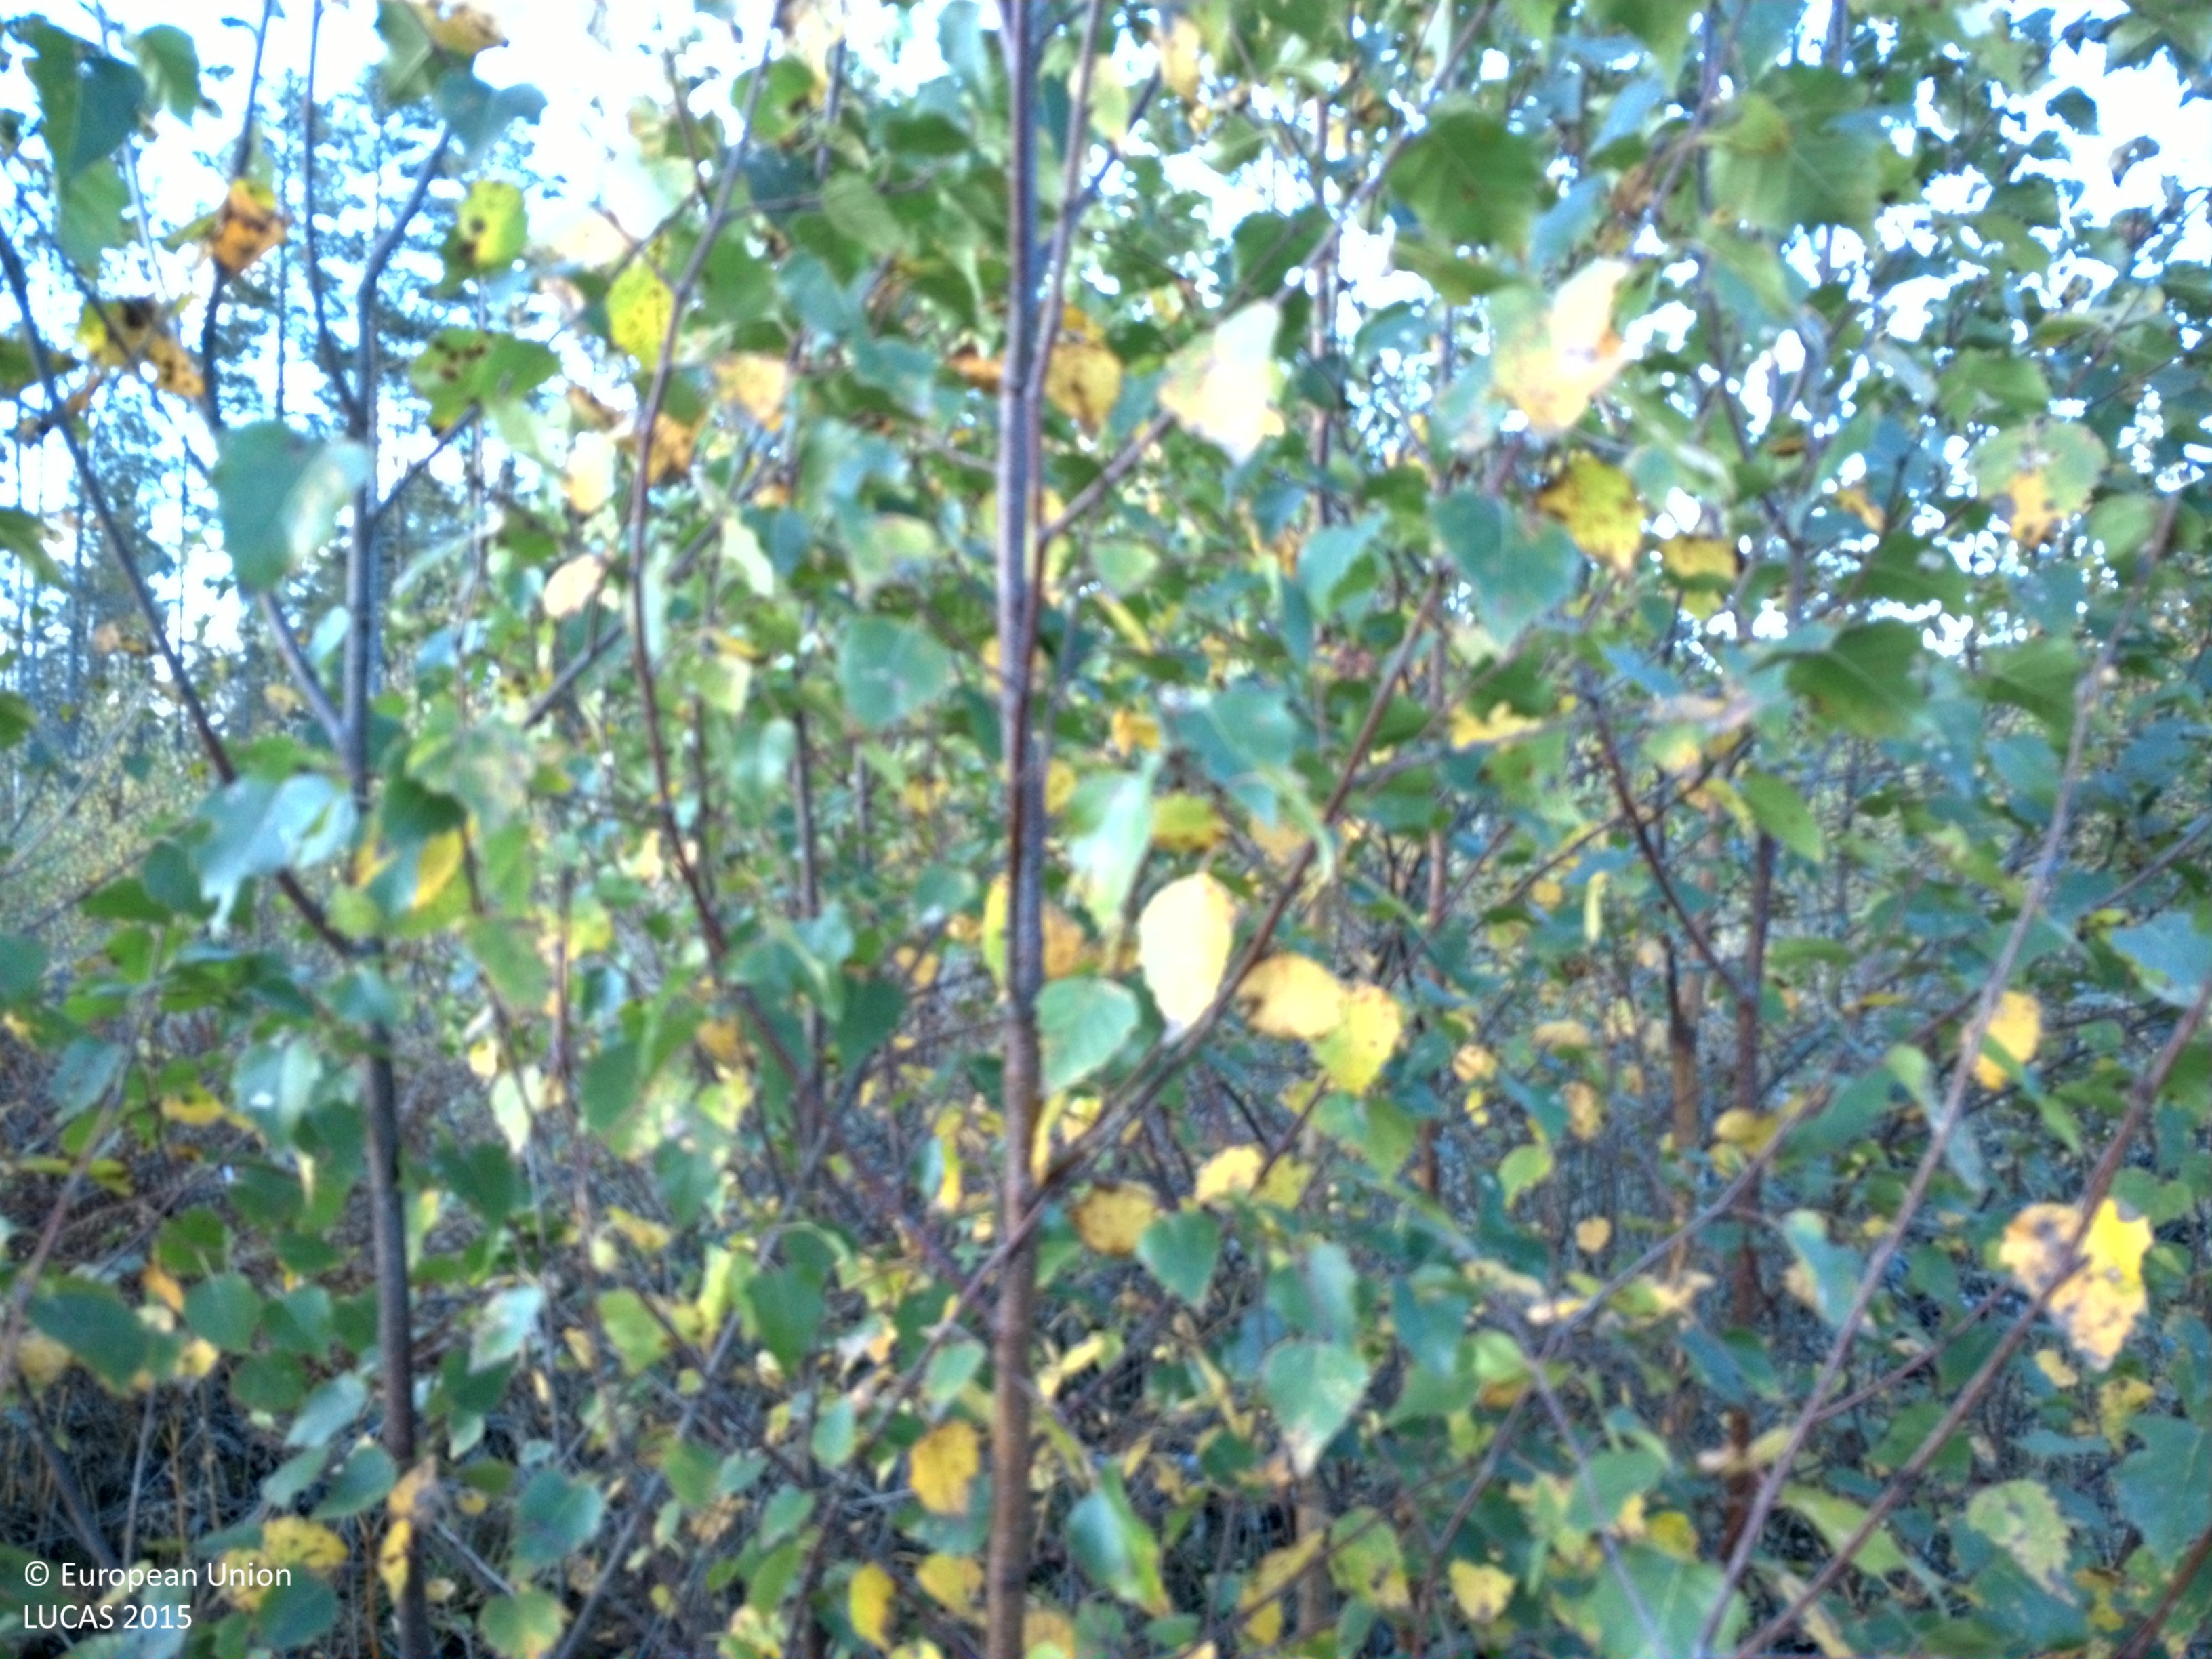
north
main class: Woodland
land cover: Broadleaved woodland
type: boreal forest
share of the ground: 25 - 50 %
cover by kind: broadleaved forest trees 45 %, herbaceous plants 40 %, unconsolidated bare surface 10 %, coniferous forest trees 5 %
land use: Forestry
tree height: < 5 m
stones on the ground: < 10 %
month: September
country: SE
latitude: 59.9736
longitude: 16.5659
